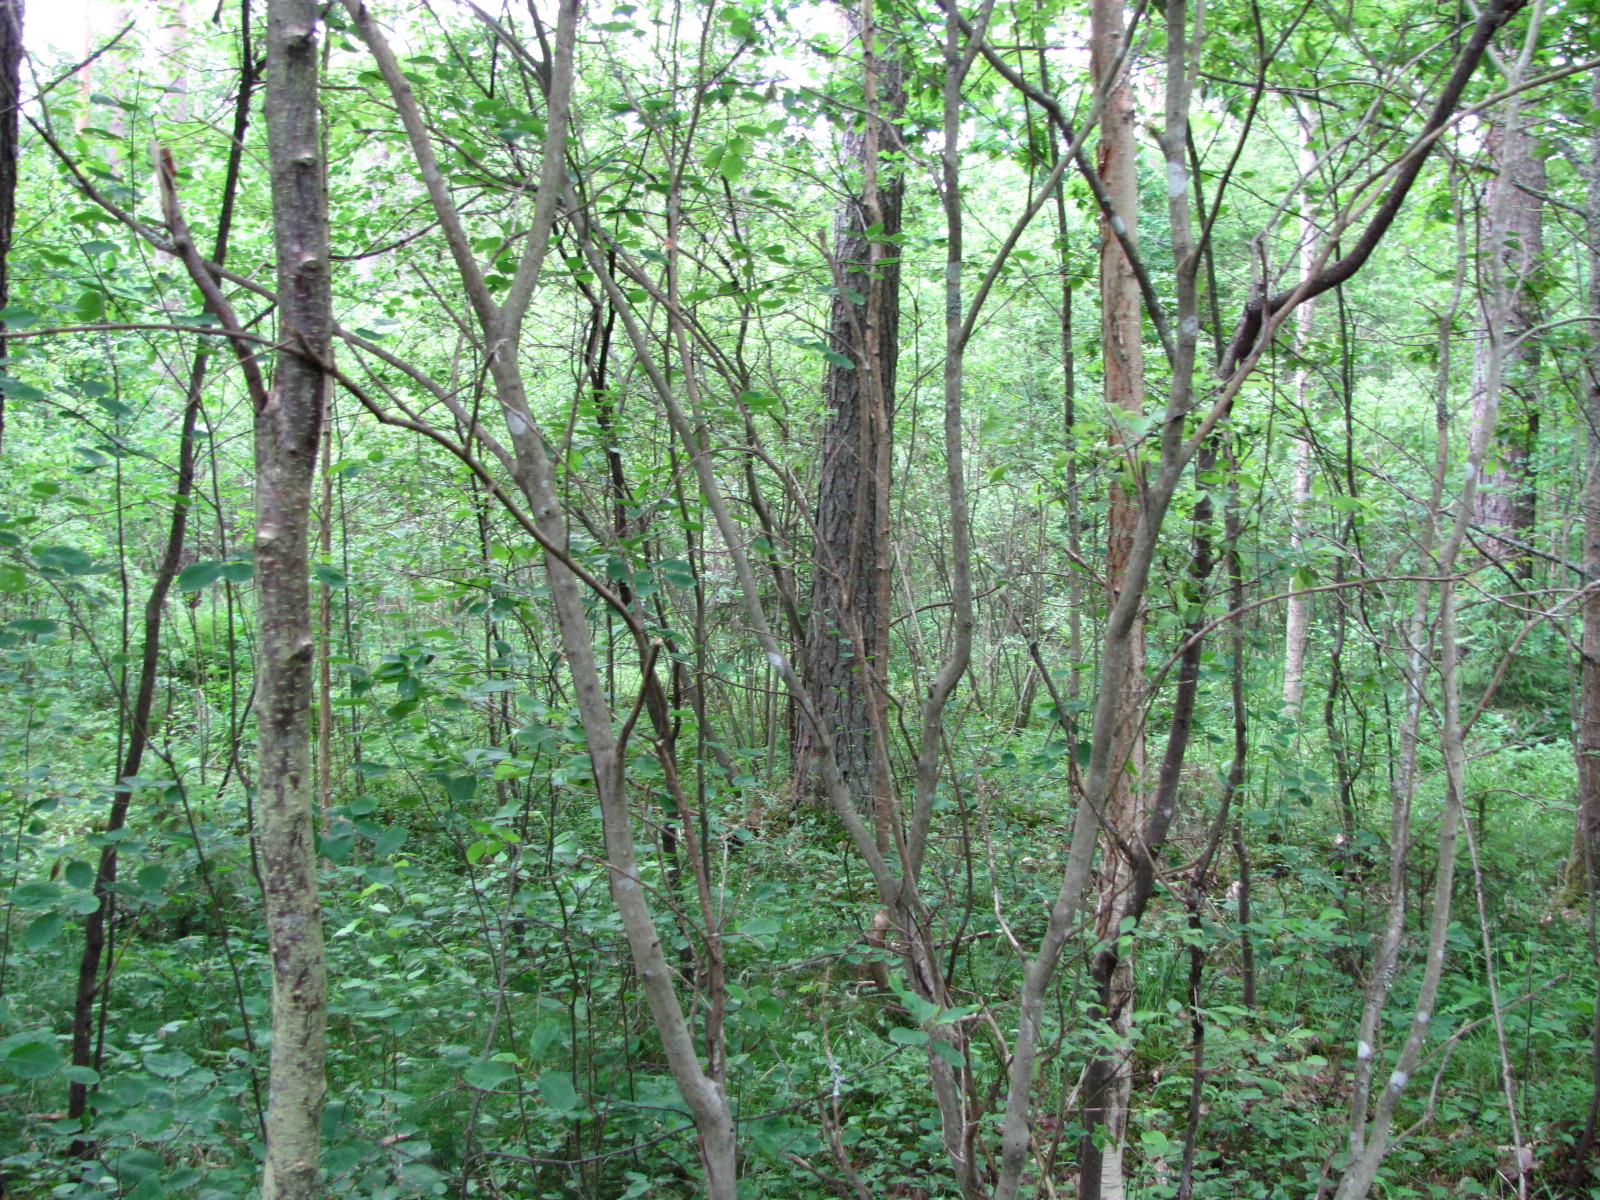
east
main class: Woodland
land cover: Pine dominated mixed woodland
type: hemiboreal forest and nemoral coniferous forest and mixed broadleaved-coniferous forest
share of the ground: > 75 %
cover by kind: coniferous forest trees 50 %, broadleaved forest trees 50 %
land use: Forestry
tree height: > 5 m
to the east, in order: Pine dominated mixed woodland; Spruce dominated coniferous woodland; Spruce dominated mixed woodland; Spruce dominated coniferous woodland; Grassland with sparse tree/shrub cover; Spruce dominated coniferous woodland; Broadleaved woodland; Spruce dominated coniferous woodland; Pine dominated mixed woodland; Ditches and canals; Shruby margins; Tracks; Pine dominated mixed woodland
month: June
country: LV
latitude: 56.8937
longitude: 23.8532
